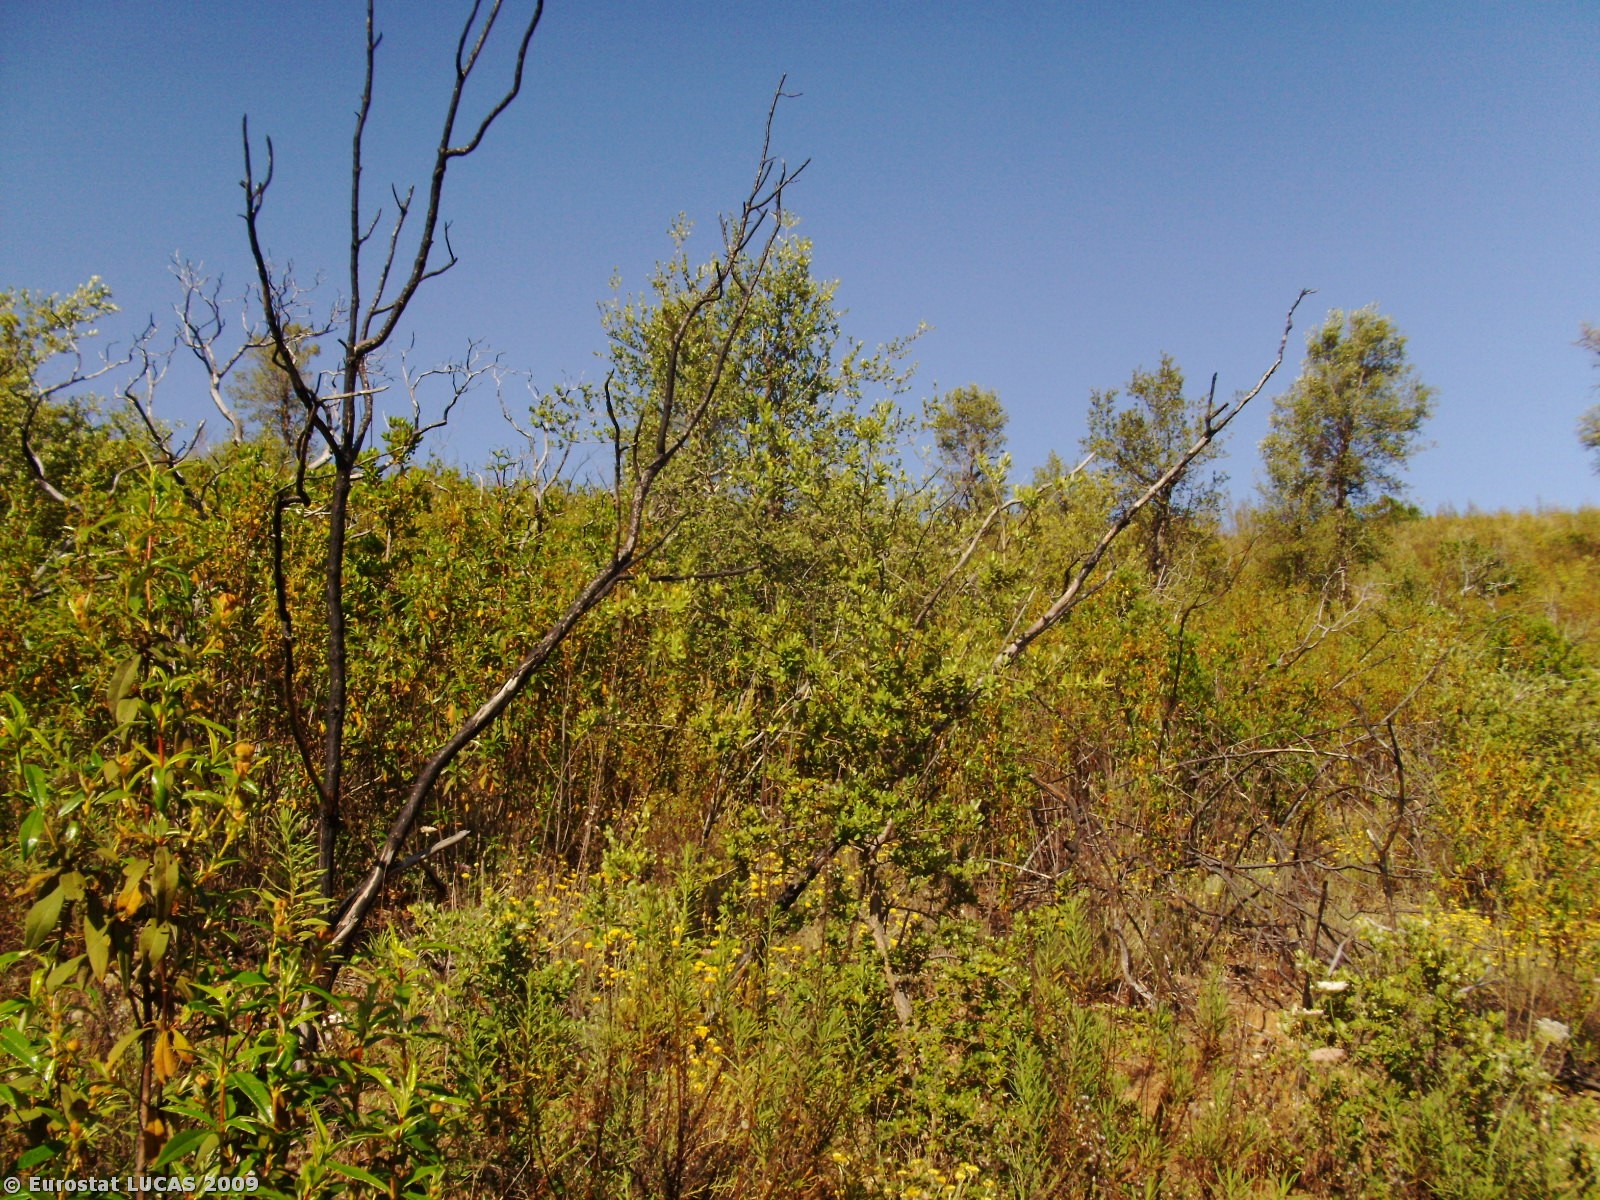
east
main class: Shrubland
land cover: Shrubland with sparse tree cover
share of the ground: > 75 %
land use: Nature reserves
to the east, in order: Shrubland with sparse tree cover
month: May
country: PT
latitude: 37.3093
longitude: -8.1977
